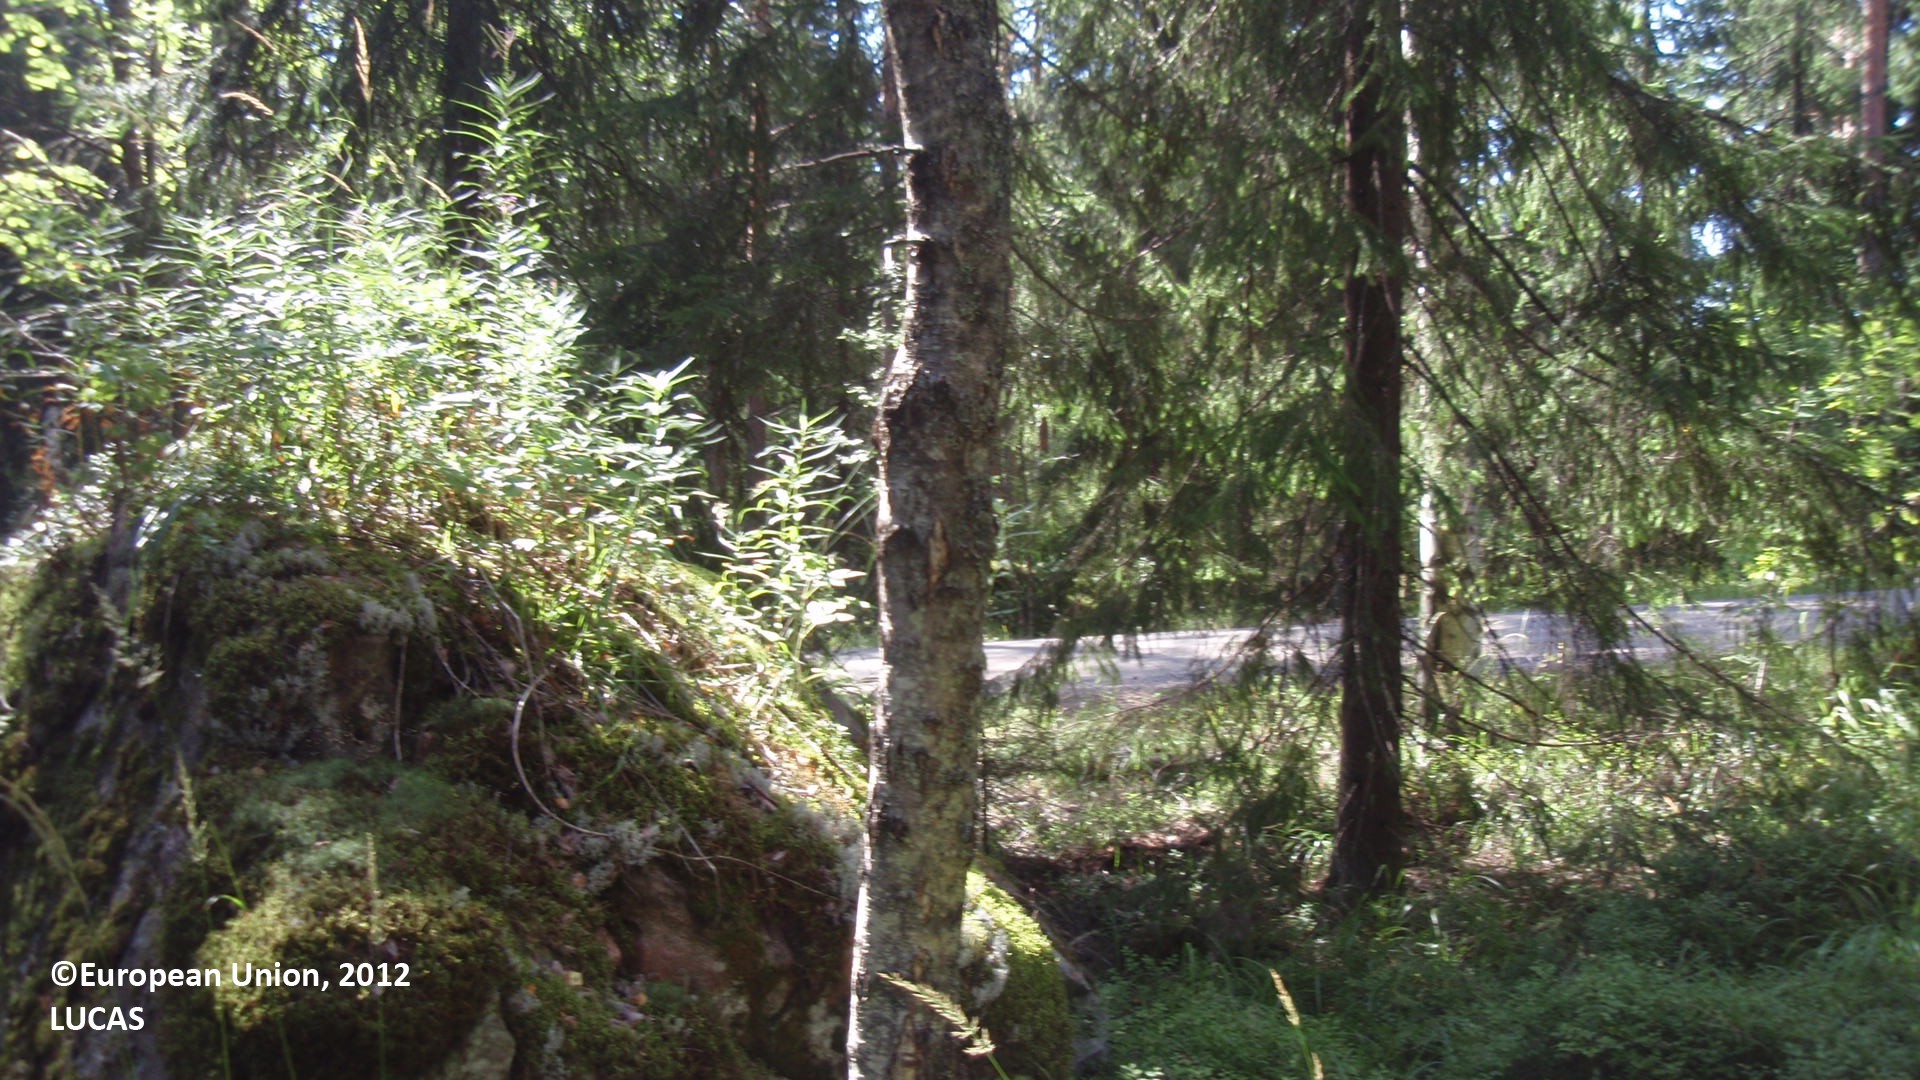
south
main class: Woodland
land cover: Pine dominated mixed woodland
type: boreal forest
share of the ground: 50 - 75 %
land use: Forestry
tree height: > 5 m
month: August
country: FI
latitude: 60.9998
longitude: 28.6578
